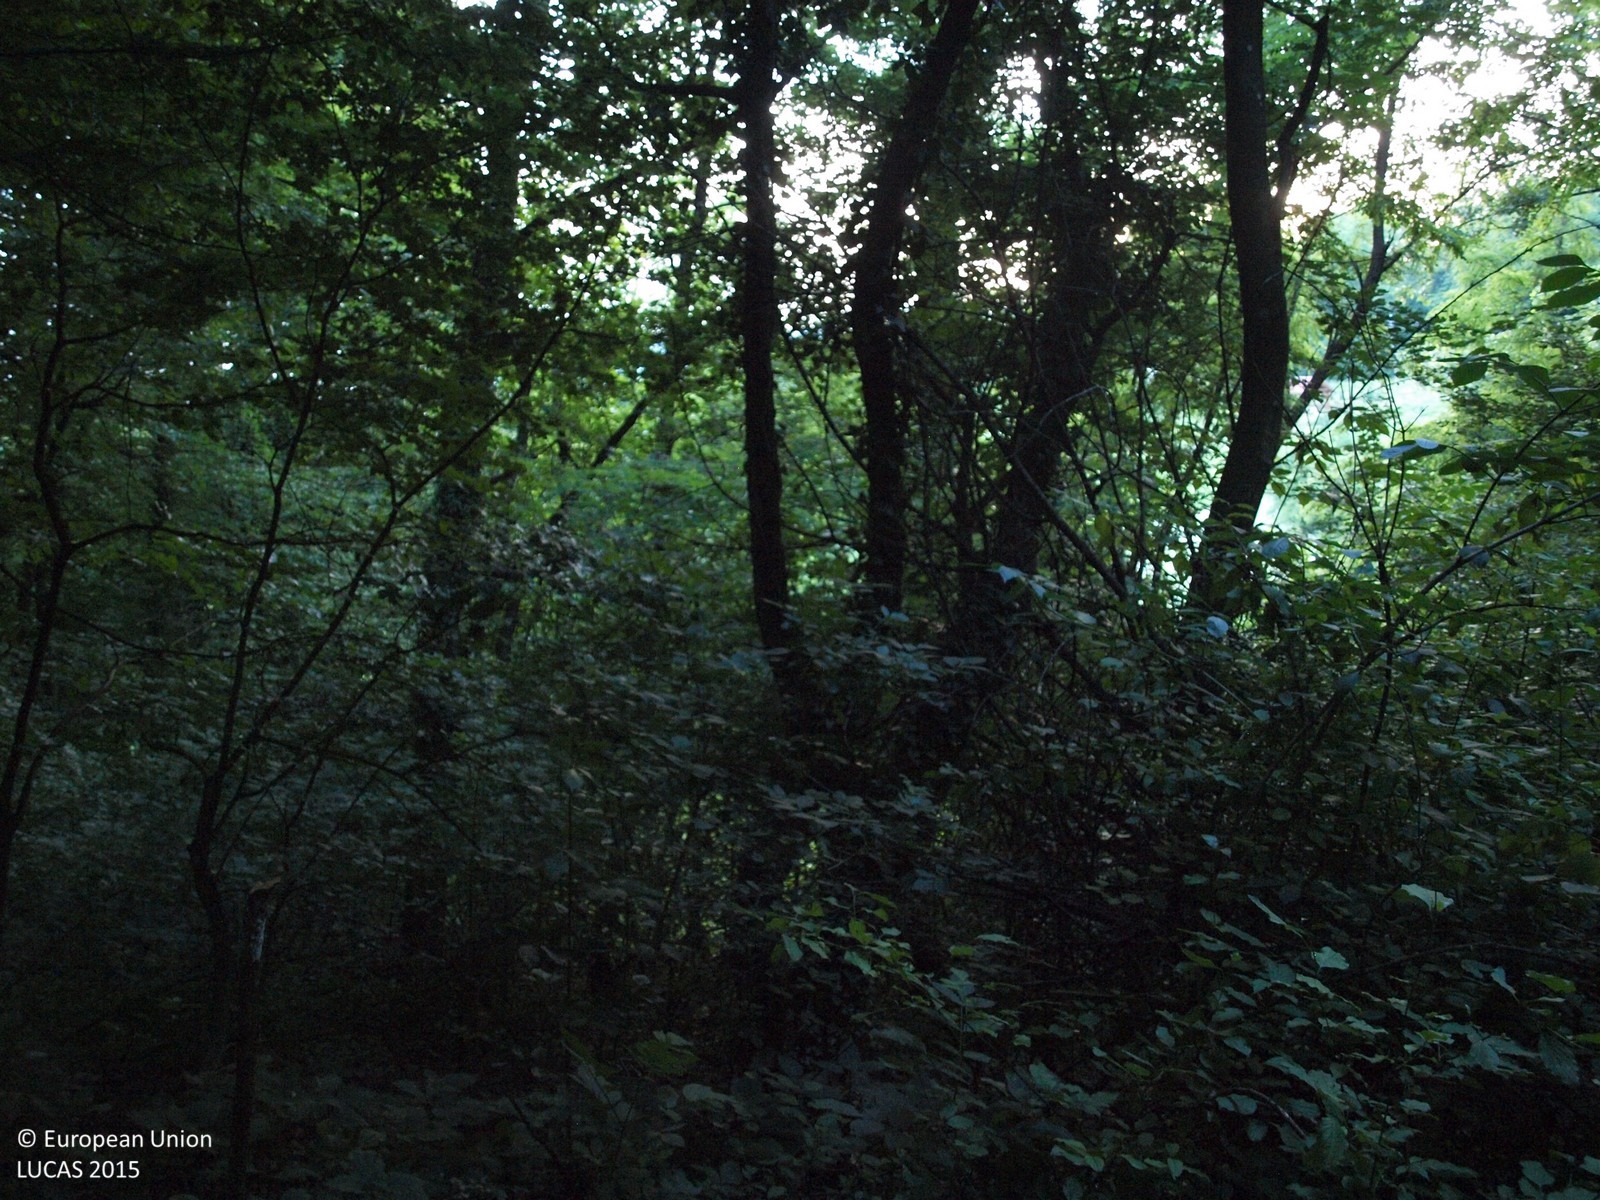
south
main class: Woodland
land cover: Broadleaved woodland
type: mesophytic deciduous forest
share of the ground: > 75 %
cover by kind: broadleaved forest trees 100 %
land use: Forestry
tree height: > 5 m
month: June
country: HR
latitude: 46.0162
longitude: 15.7457
